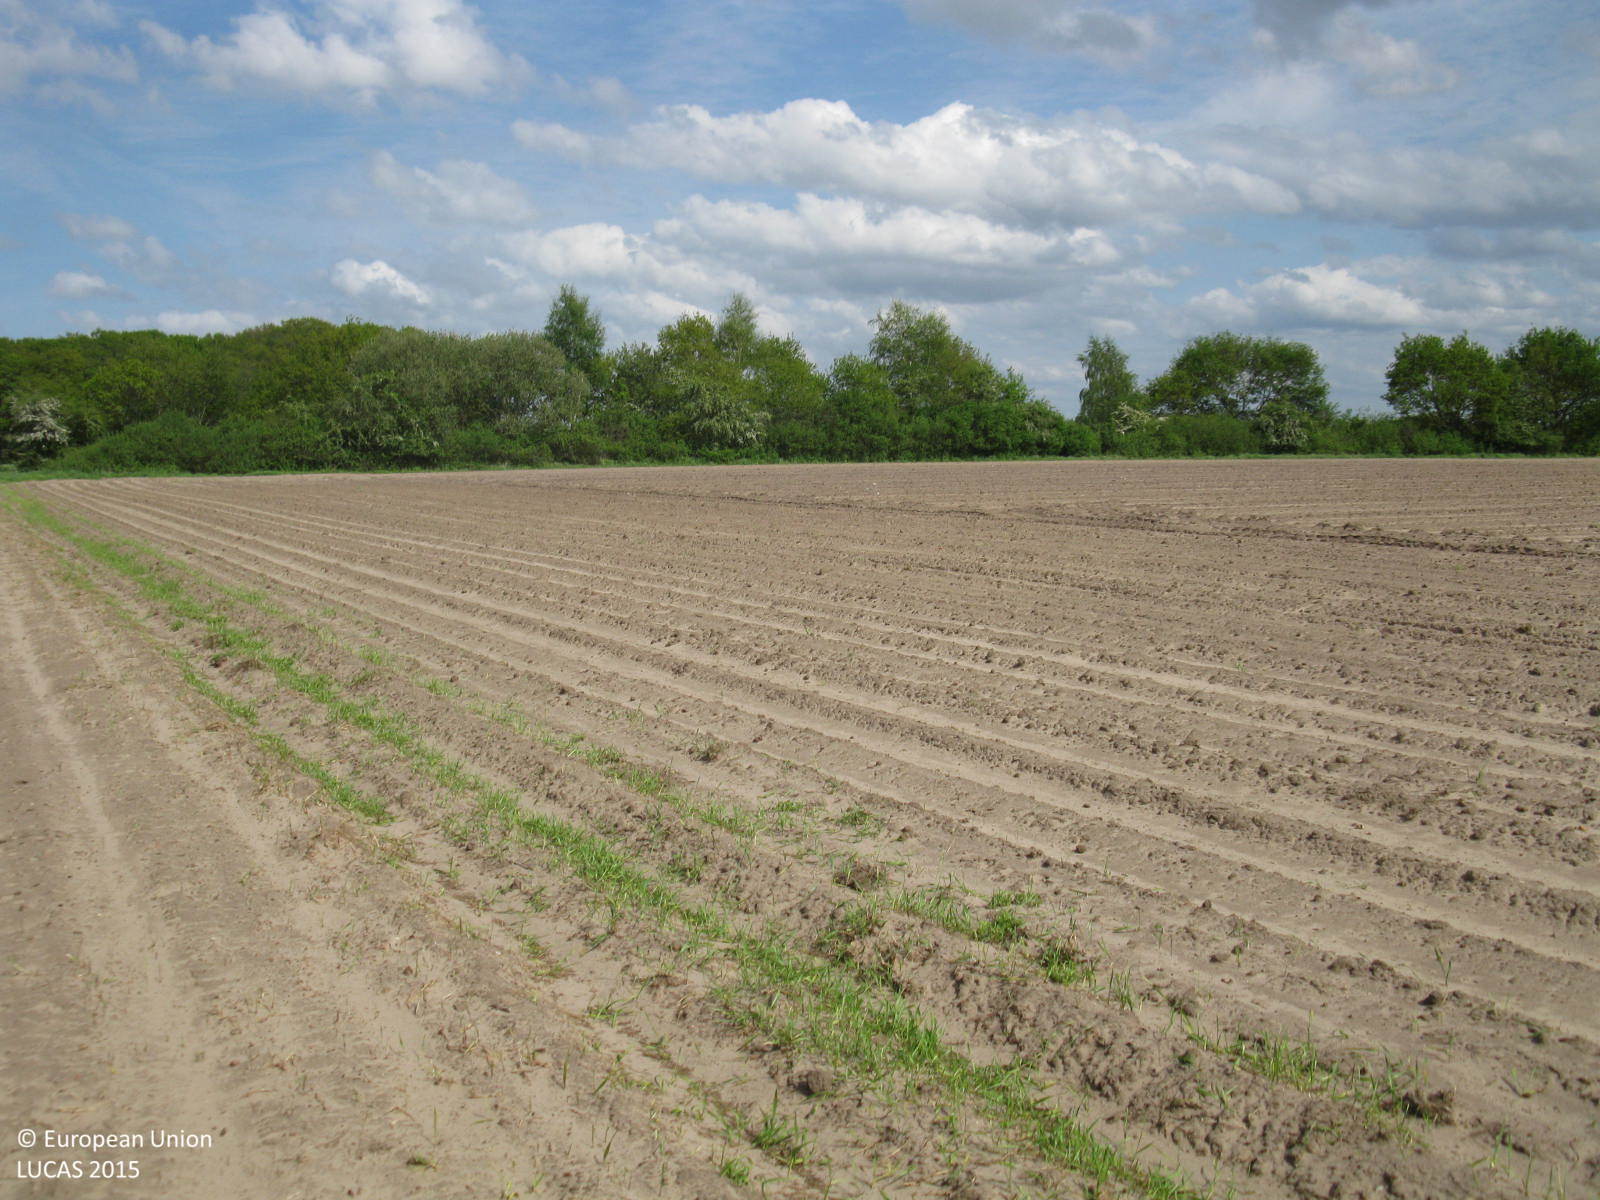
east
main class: Cropland
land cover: Other fresh vegetables
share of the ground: 25 - 50 %
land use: Agriculture (excluding fallow land and kitchen gardens)
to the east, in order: Other fresh vegetables; Potatoes; Broadleaved woodland; Paved roads, cycling and walking lanes; Broadleaved woodland; Potatoes; Grass margins; Fences; Grassland without tree/shrub cover; Fences; Oats
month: May
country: DE
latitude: 52.9950
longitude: 7.3336
